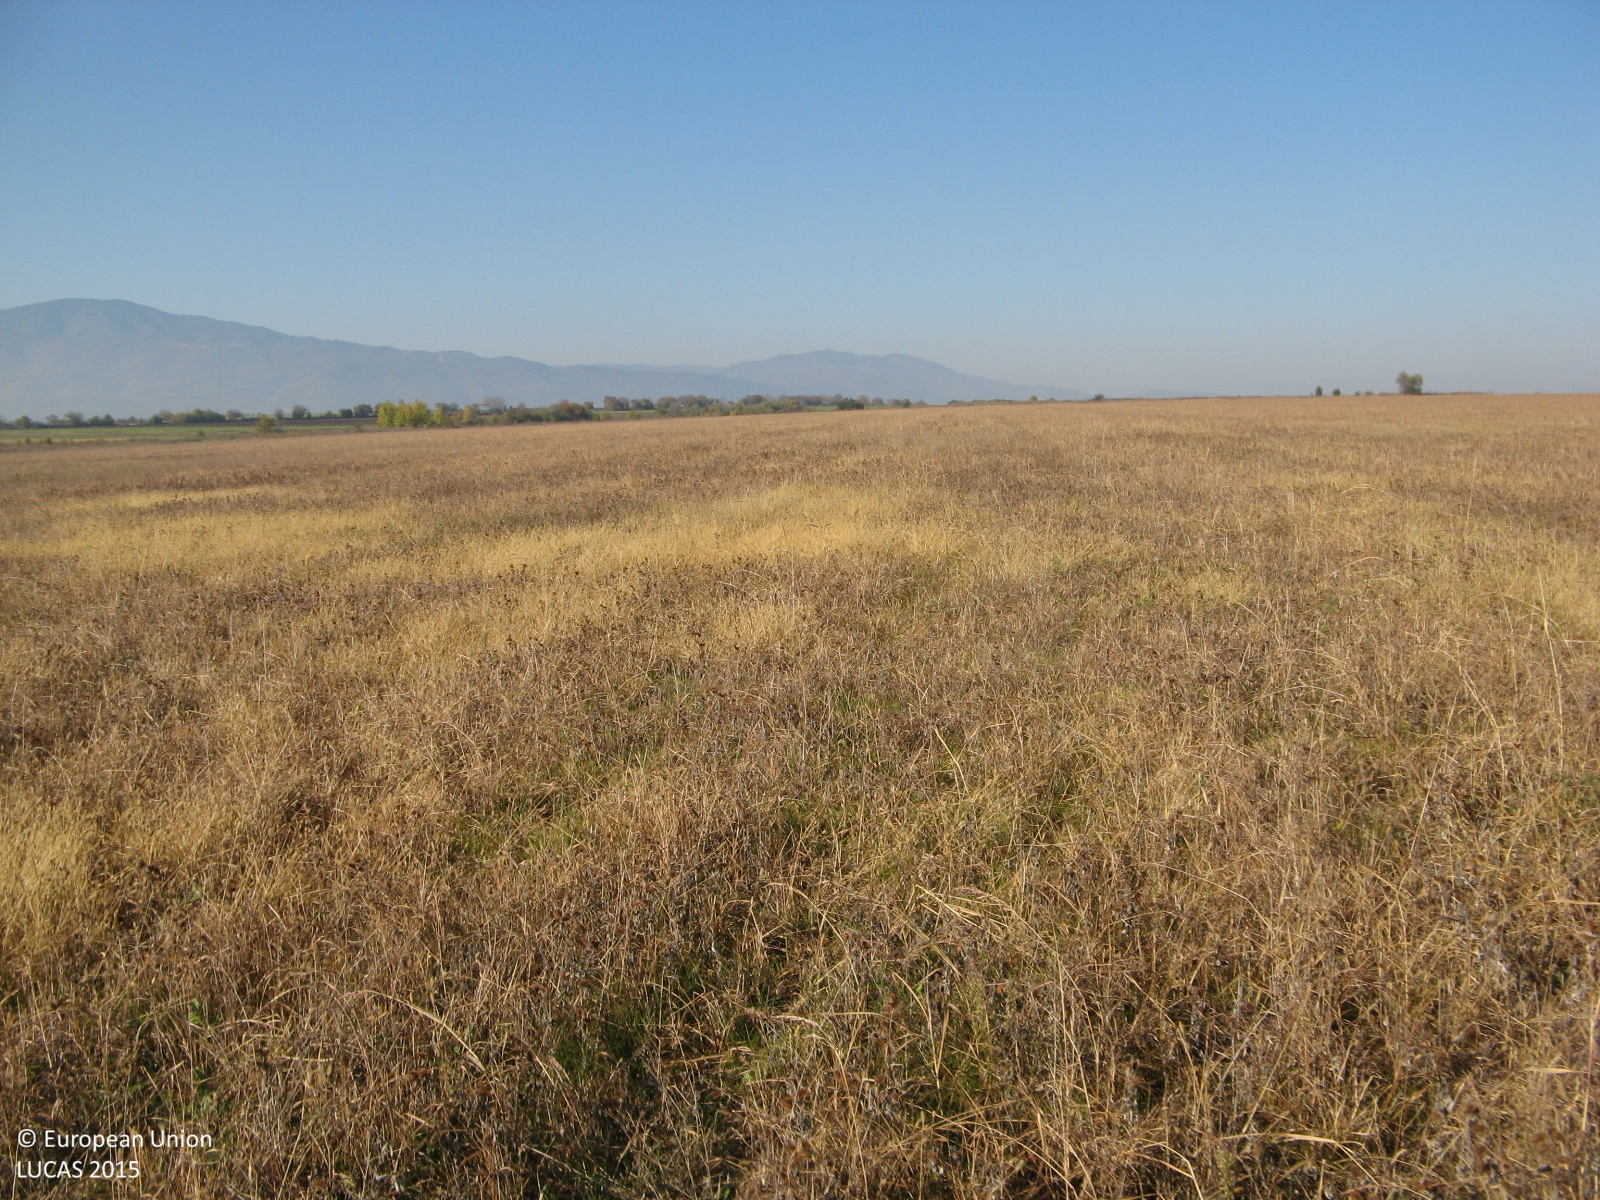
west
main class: Cropland
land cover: Common wheat
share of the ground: < 10 %
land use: Agriculture (excluding fallow land and kitchen gardens)
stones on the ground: < 10 %
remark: Harvested field
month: November
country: BG
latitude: 42.0008
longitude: 25.0375
